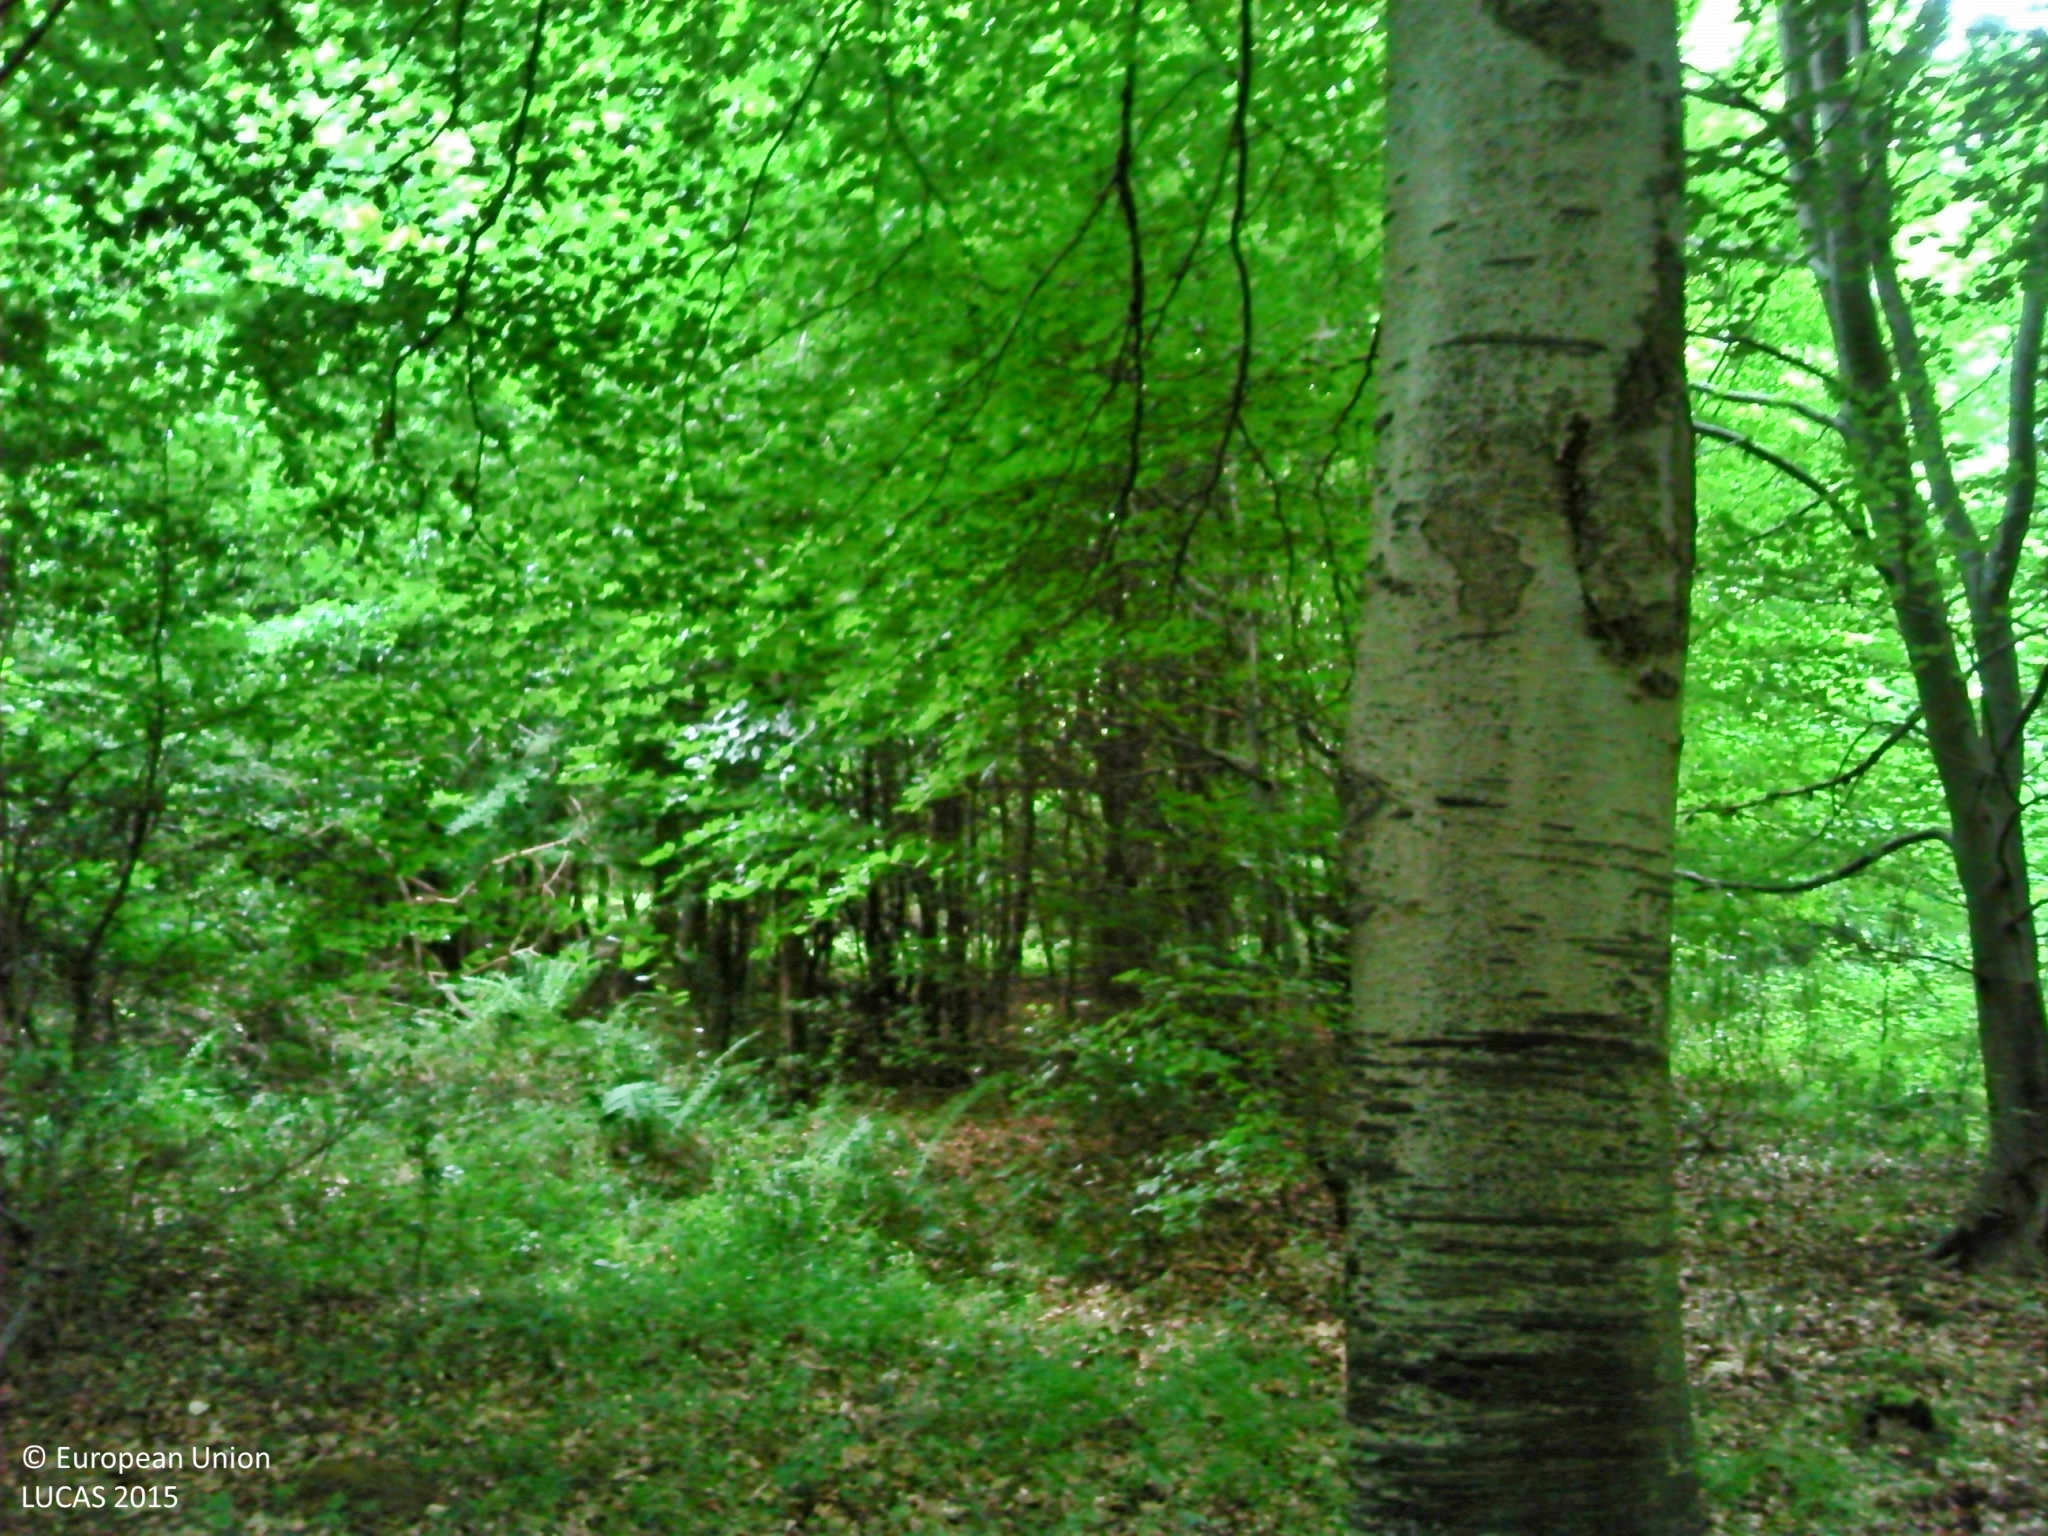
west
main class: Woodland
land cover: Broadleaved woodland
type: beech forest
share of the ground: > 75 %
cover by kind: broadleaved forest trees 90 %, shrubs 5 %, herbaceous plants 5 %
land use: Forestry
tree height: > 5 m
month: June
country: FR
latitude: 49.3311
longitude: 2.9036
